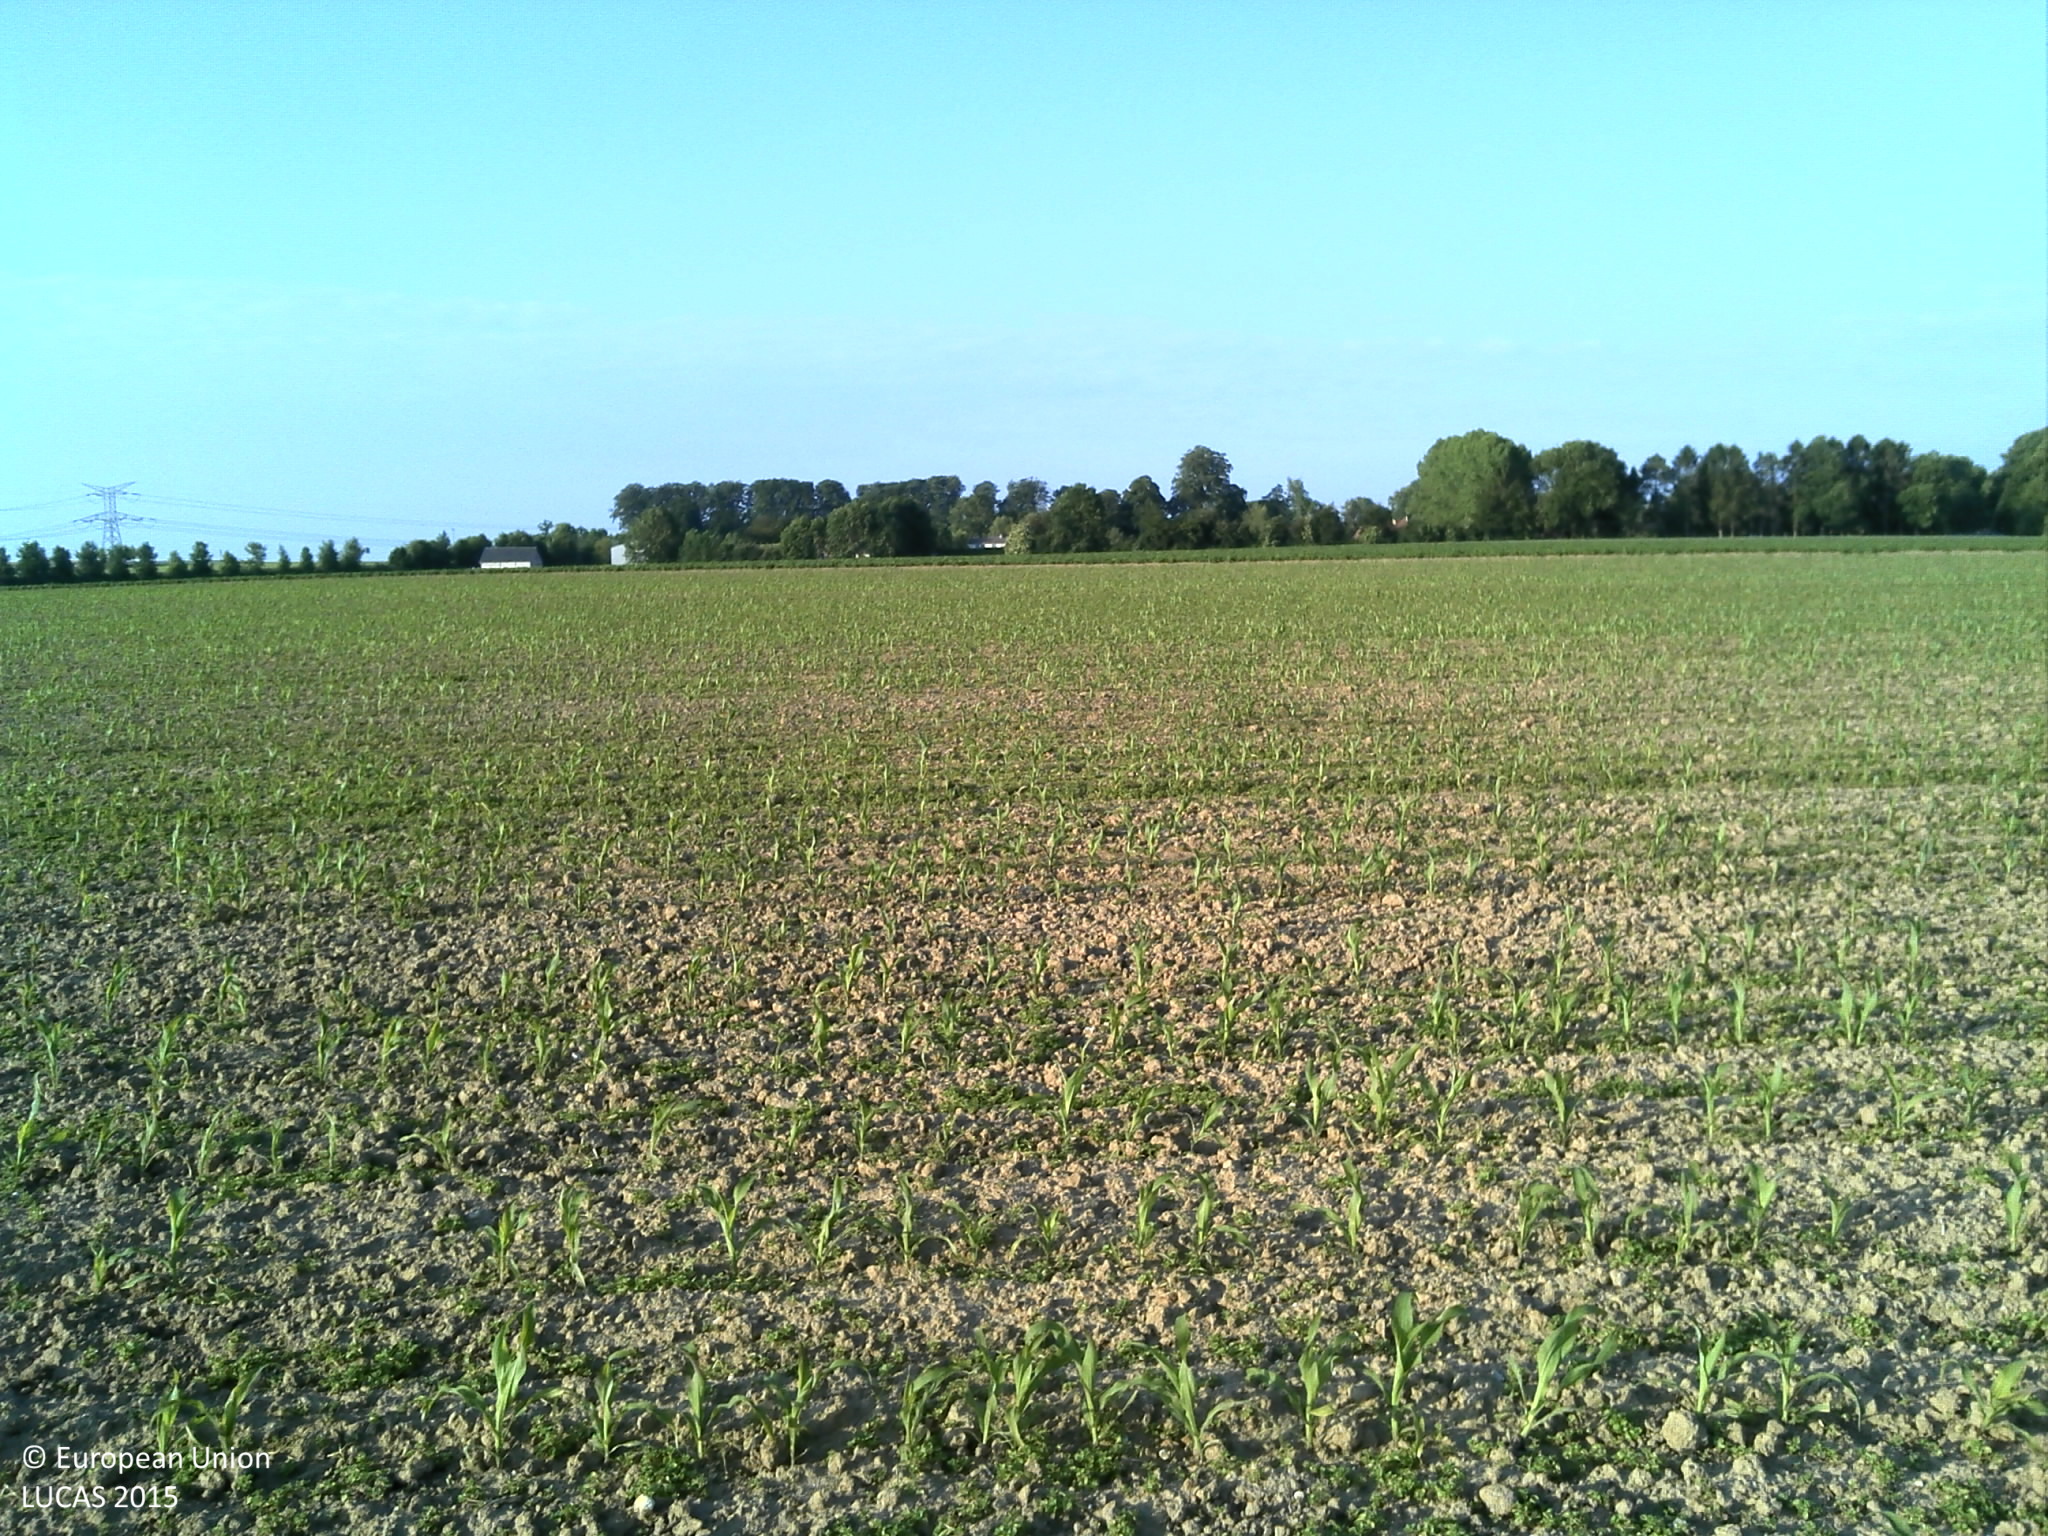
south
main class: Cropland
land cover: Maize
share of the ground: < 10 %
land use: Agriculture (excluding fallow land and kitchen gardens)
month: June
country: FR
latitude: 49.7238
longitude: 1.0585
